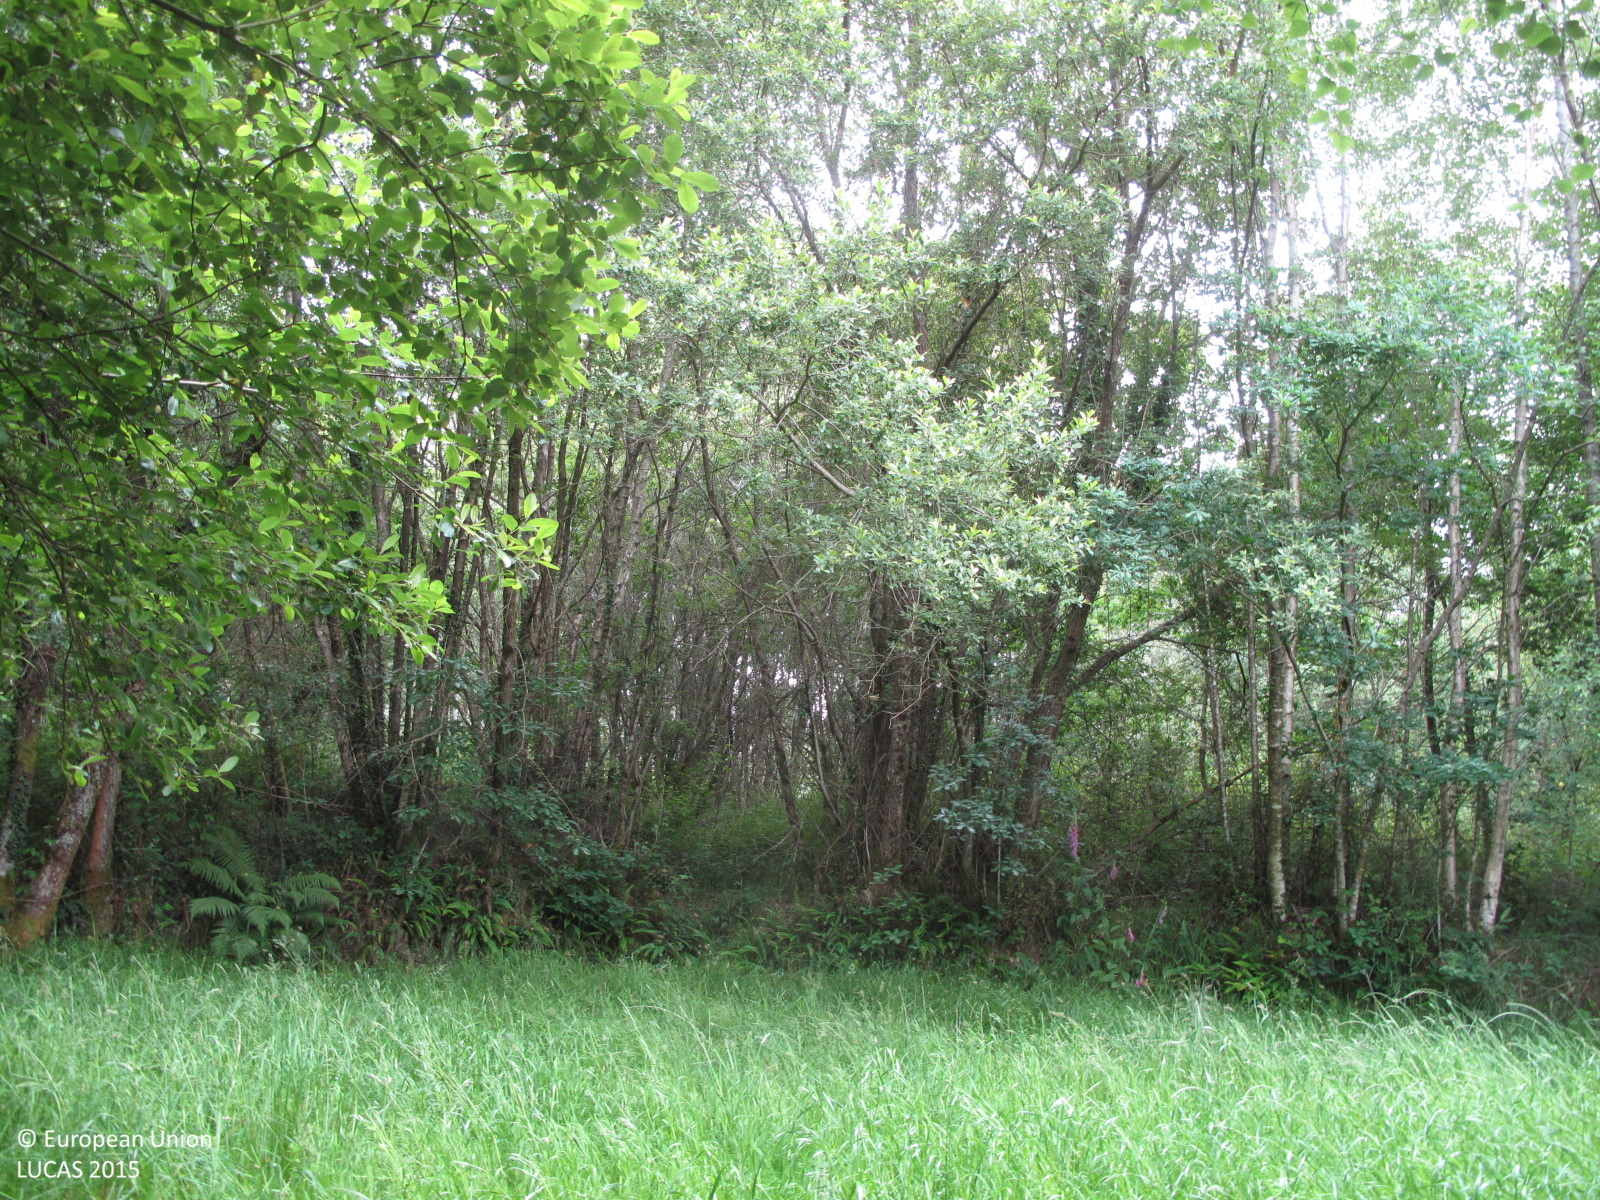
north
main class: Woodland
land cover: Broadleaved woodland
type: acidophilous oak and oak-birch forest
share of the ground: > 75 %
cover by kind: broadleaved forest trees 90 %, shrubs 5 %, herbaceous plants 5 %
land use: Semi-natural and natural areas not in use
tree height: > 5 m
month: June
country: ES
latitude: 43.1378
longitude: -8.5625
